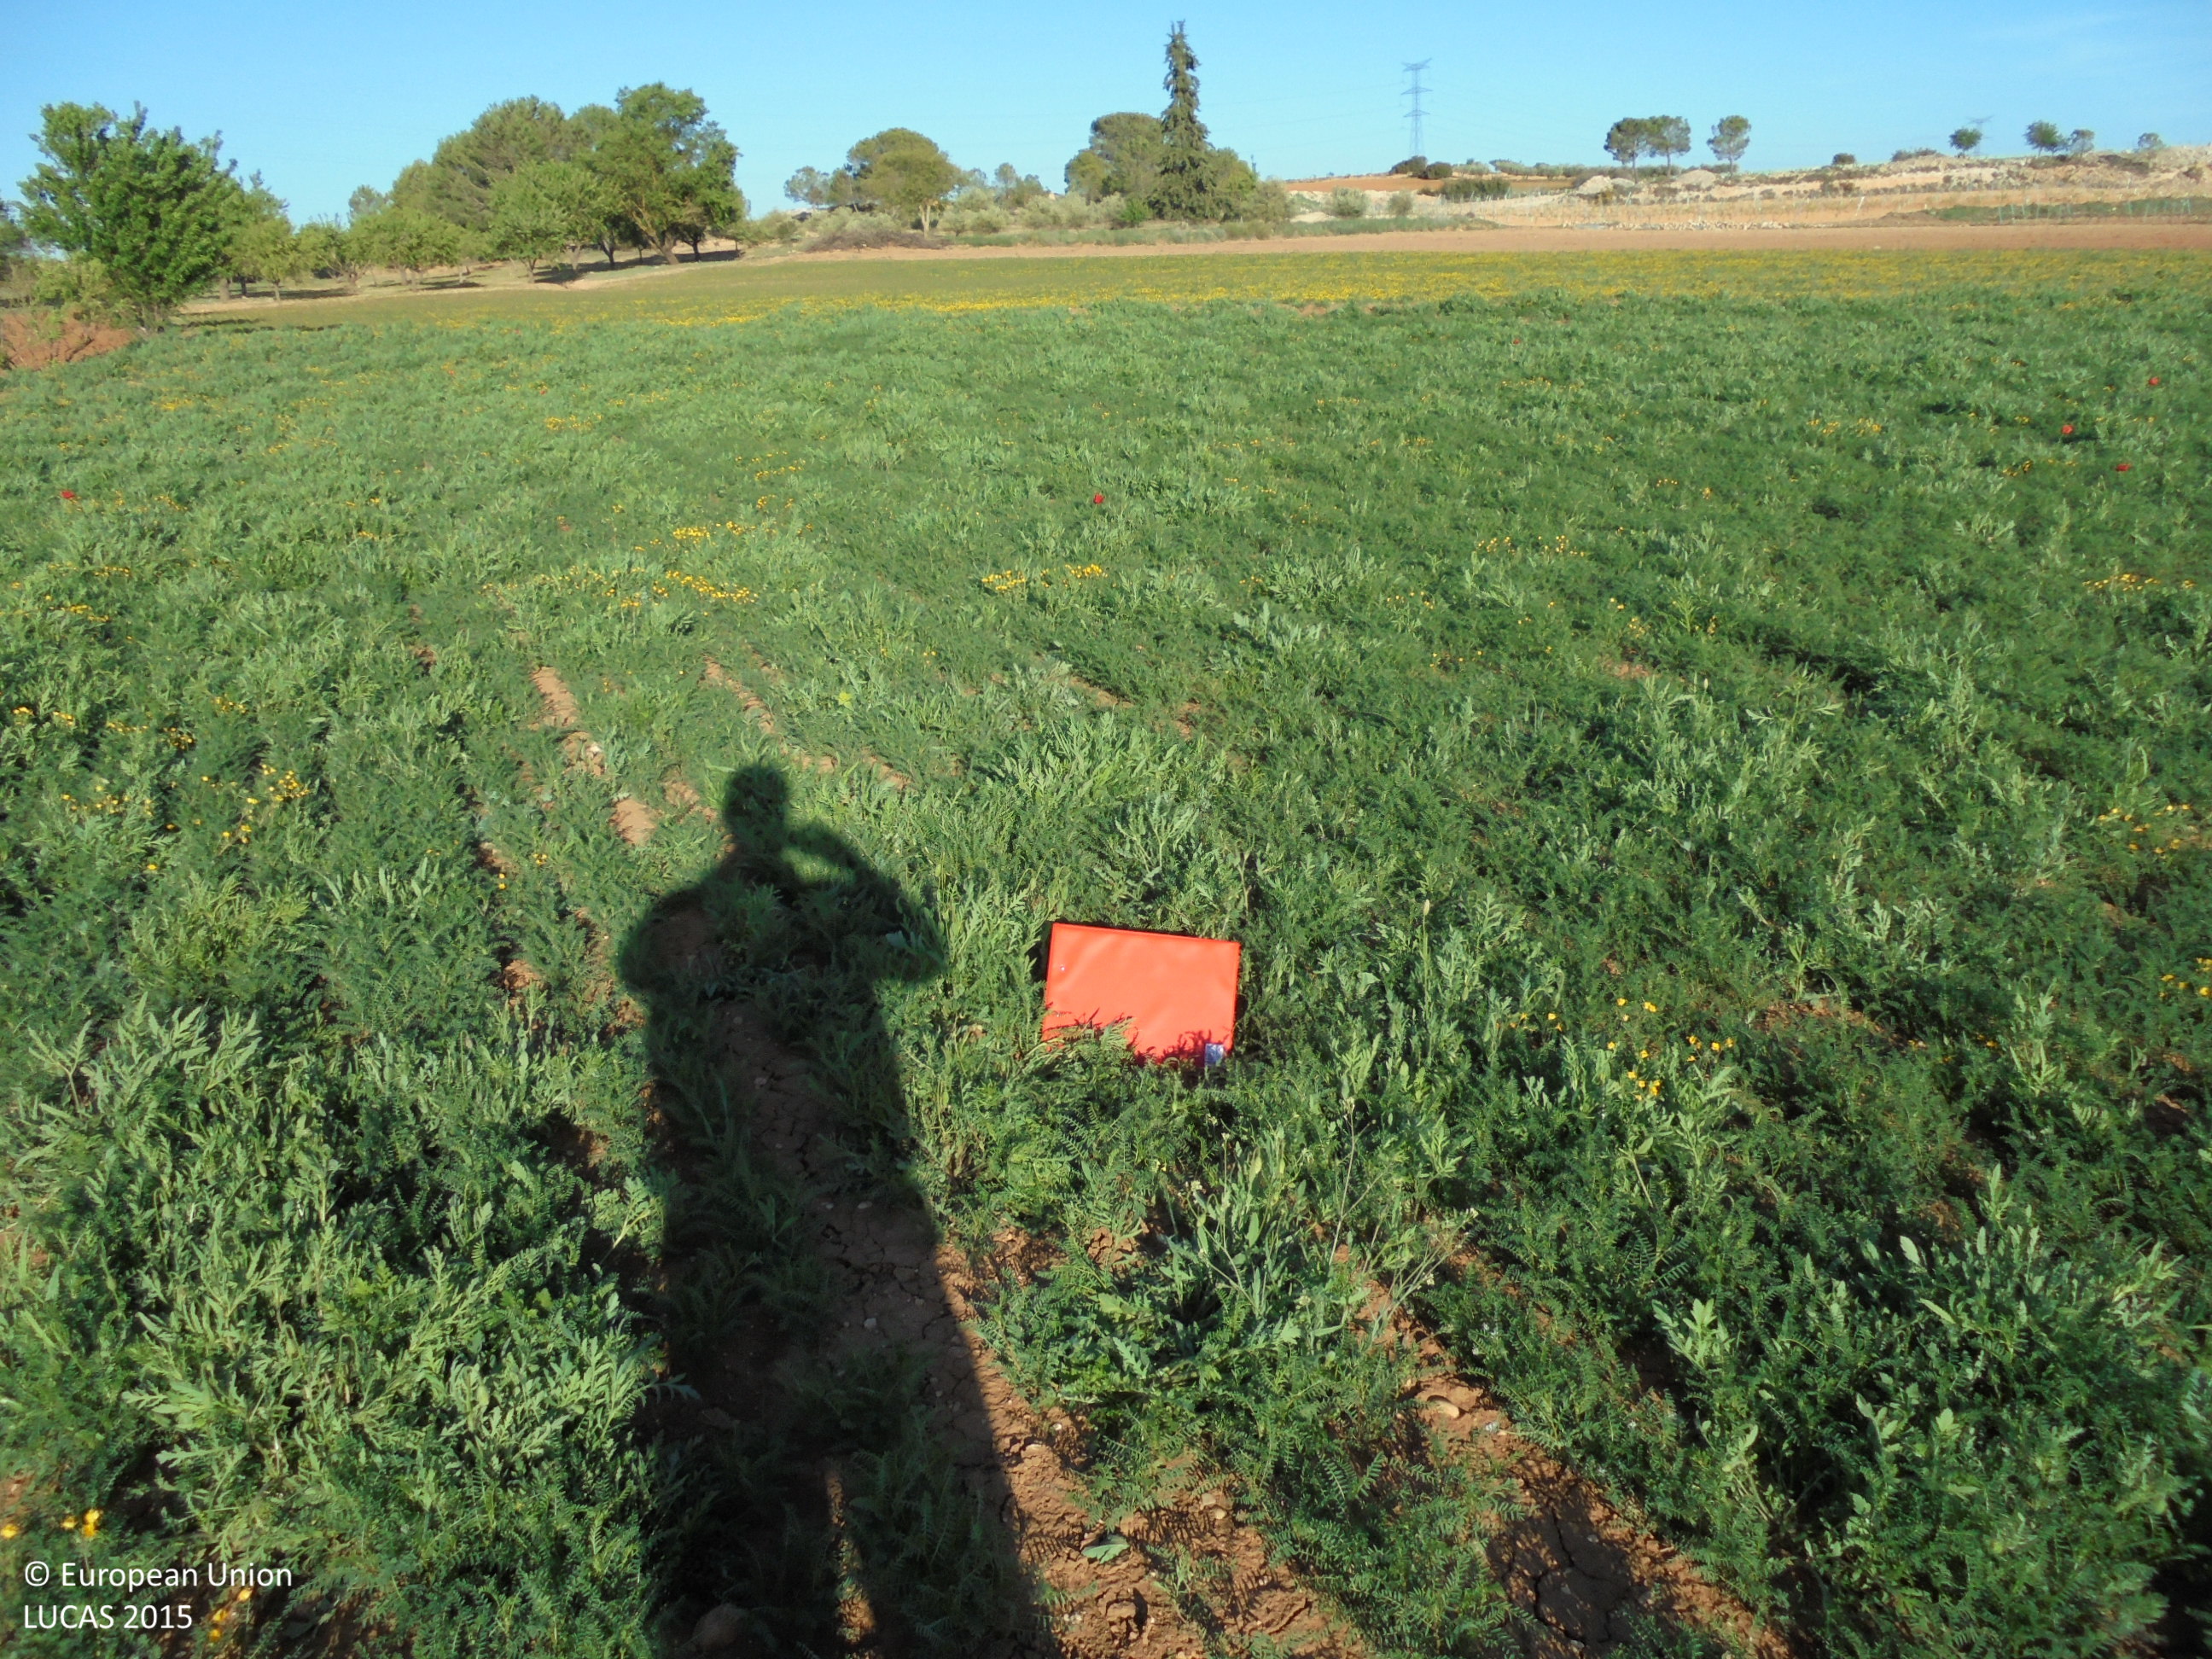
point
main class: Cropland
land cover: Dry pulses
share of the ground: > 75 %
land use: Agriculture (excluding fallow land and kitchen gardens)
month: April
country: ES
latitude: 39.2615
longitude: -1.7897
